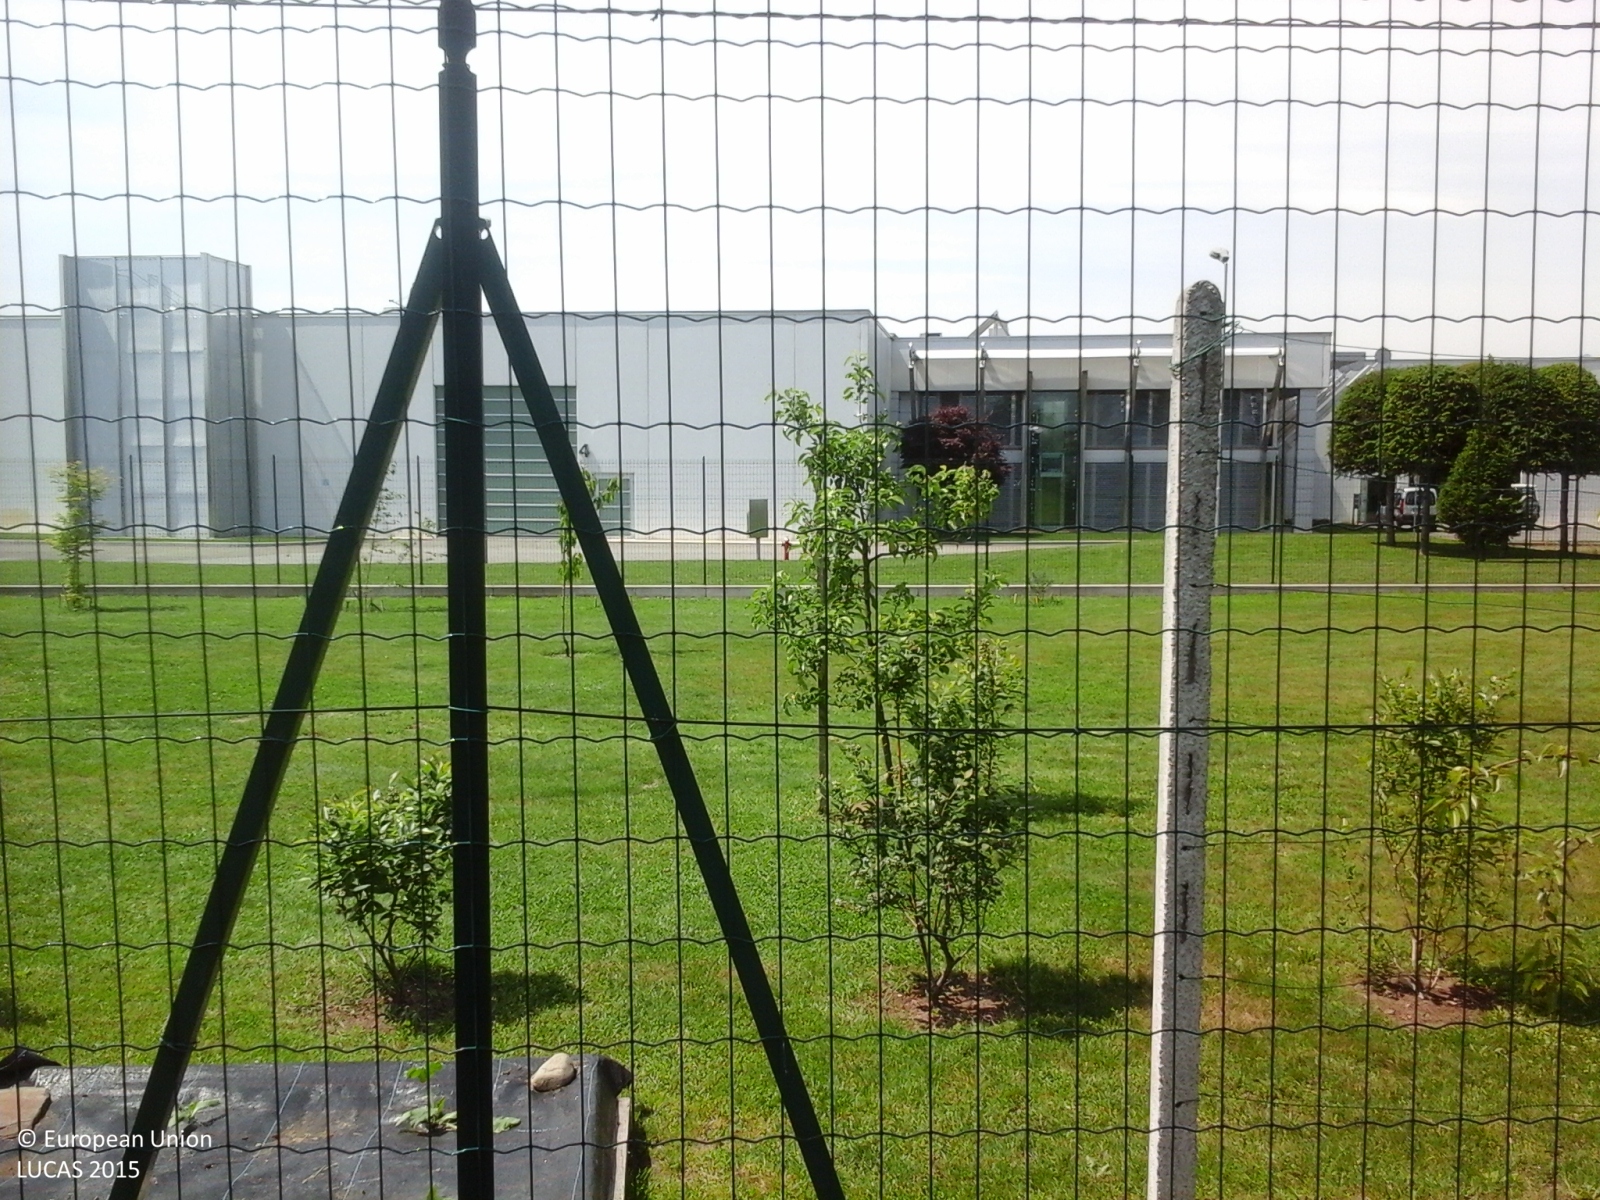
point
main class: Grassland
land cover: Grassland with sparse tree/shrub cover
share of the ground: > 75 %
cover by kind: herbaceous plants 95 %, broadleaved forest trees 5 %
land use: Other primary production
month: May
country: IT
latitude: 45.7273
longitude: 8.4476
